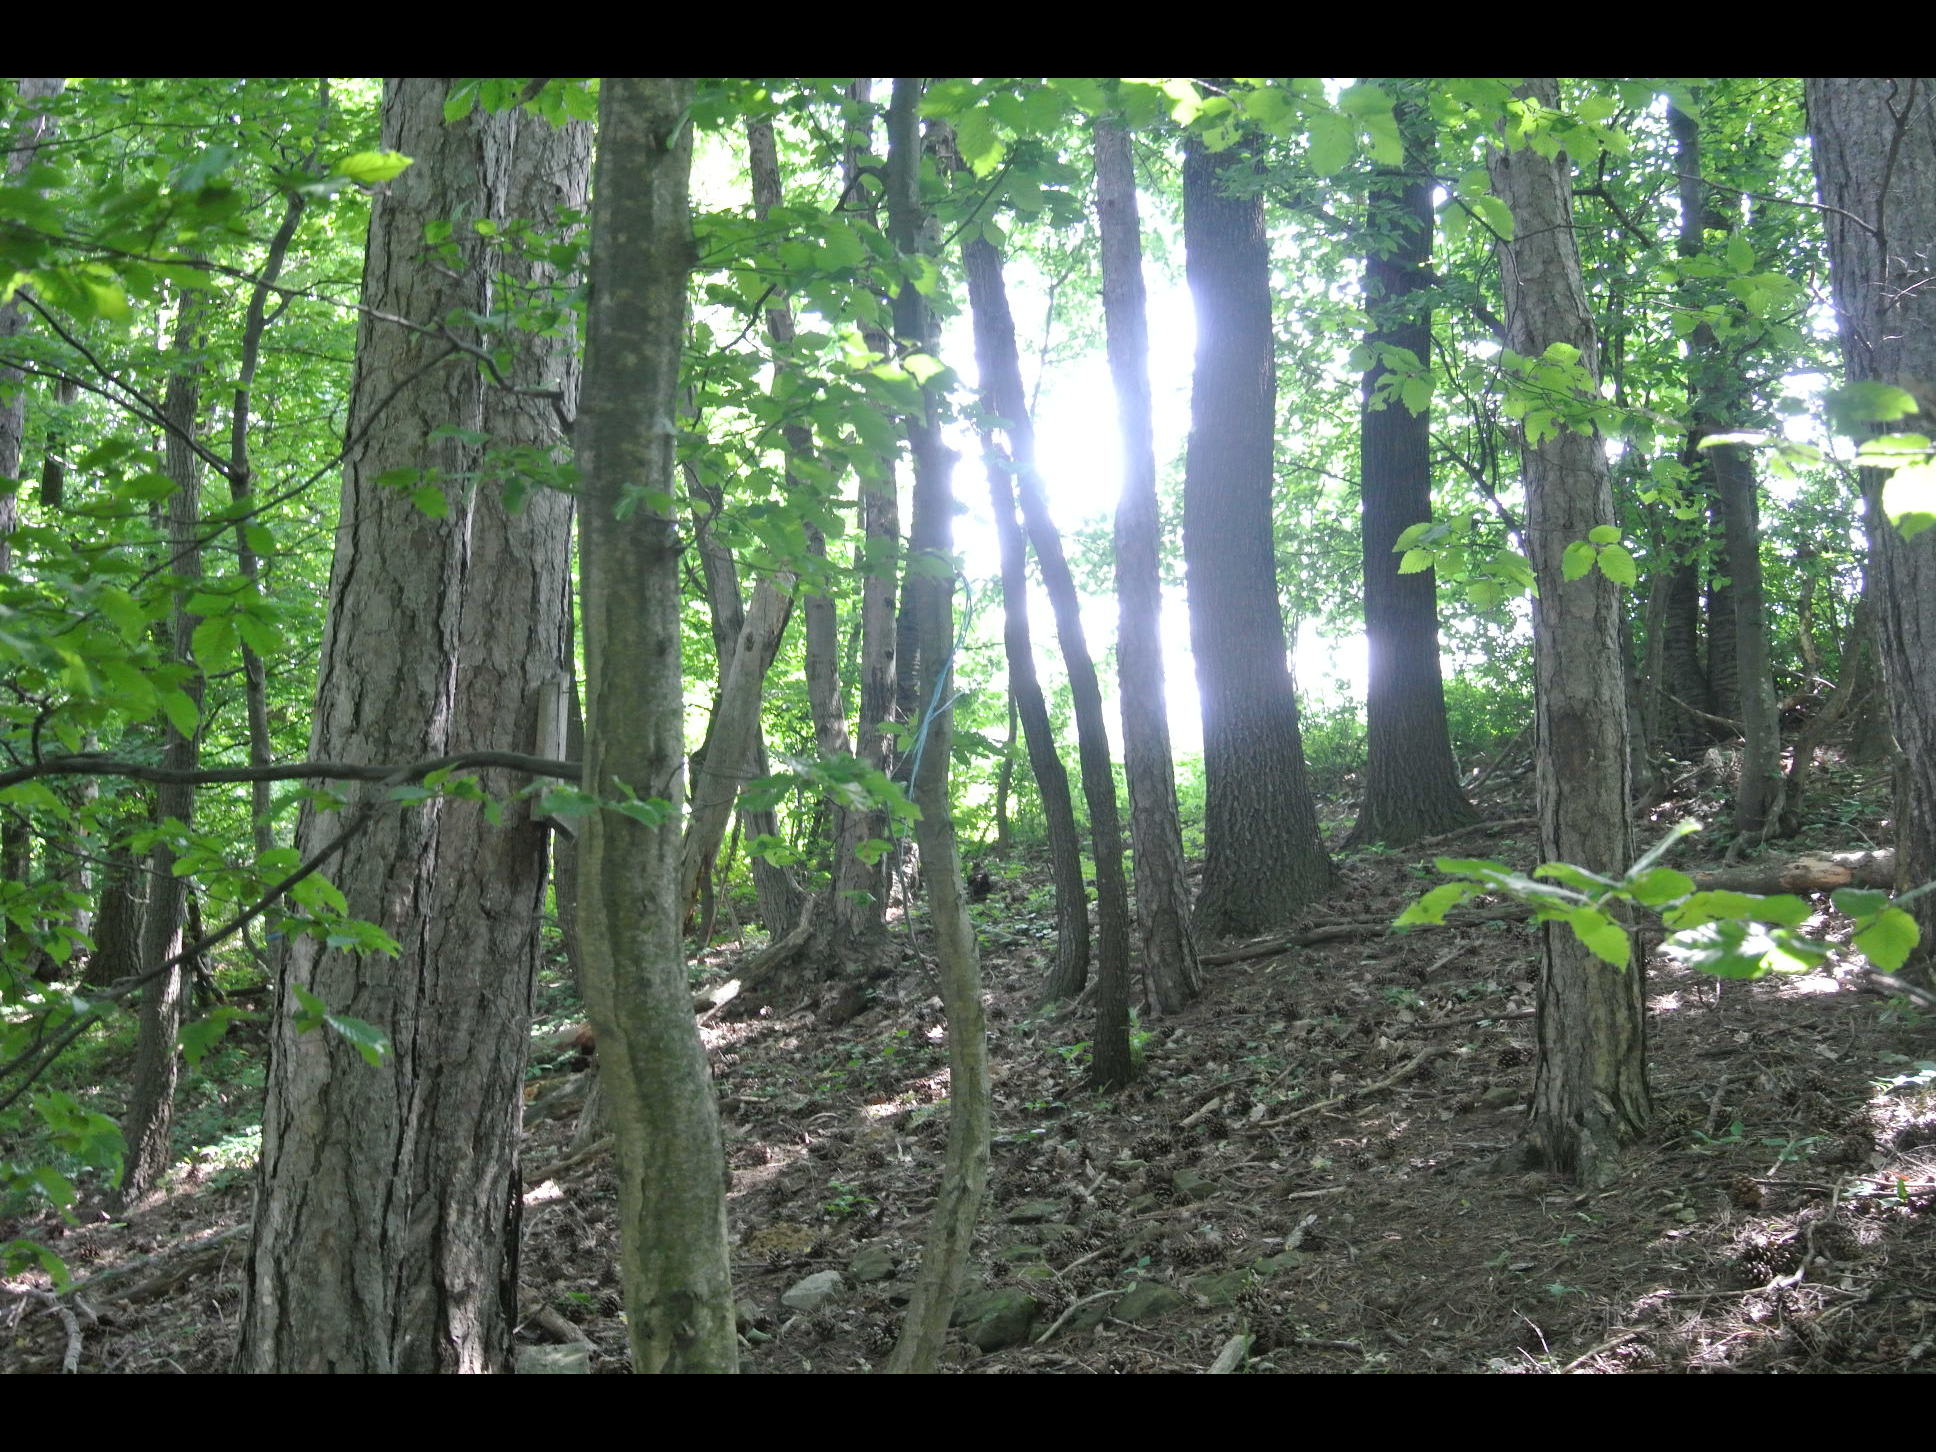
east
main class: Woodland
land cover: Broadleaved woodland
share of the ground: > 75 %
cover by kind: broadleaved forest trees 100 %
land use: Forestry
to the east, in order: Broadleaved woodland; Grassland without tree/shrub cover; Electric lines; Grassland without tree/shrub cover
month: June
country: AT
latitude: 48.0392
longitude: 16.0527
